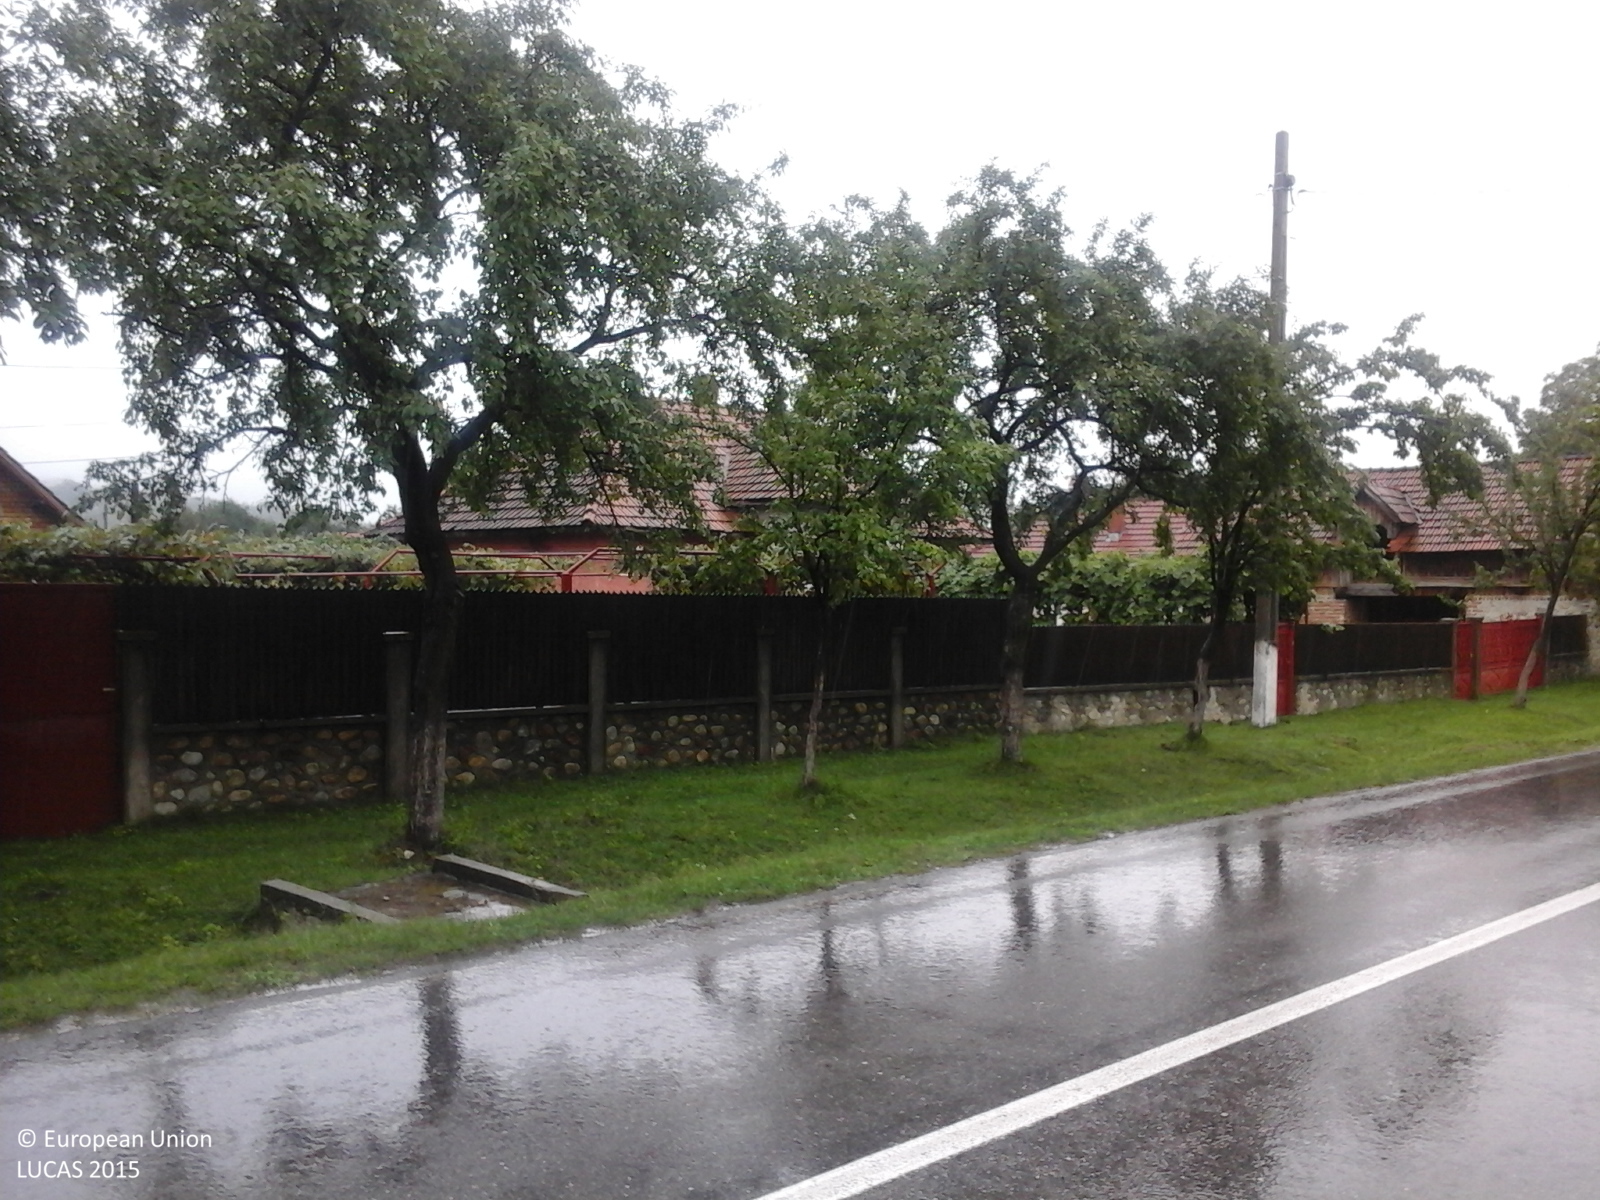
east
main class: Grassland
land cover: Spontaneously vegetated surfaces
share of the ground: > 75 %
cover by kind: herbaceous plants 100 %
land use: Agriculture (excluding fallow land and kitchen gardens)
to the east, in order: Spontaneously vegetated surfaces; Abandoned hedges; Arable land (only in case pi); Artificial constructions in urban areas; Abandoned hedges; Spontaneously vegetated surfaces; Artificial constructions in urban areas; Permanent crops (only in case pi); Arable land (only in case pi); Abandoned hedges; Arable land (only in case pi)
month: September
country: RO
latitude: 45.1783
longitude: 23.7944
